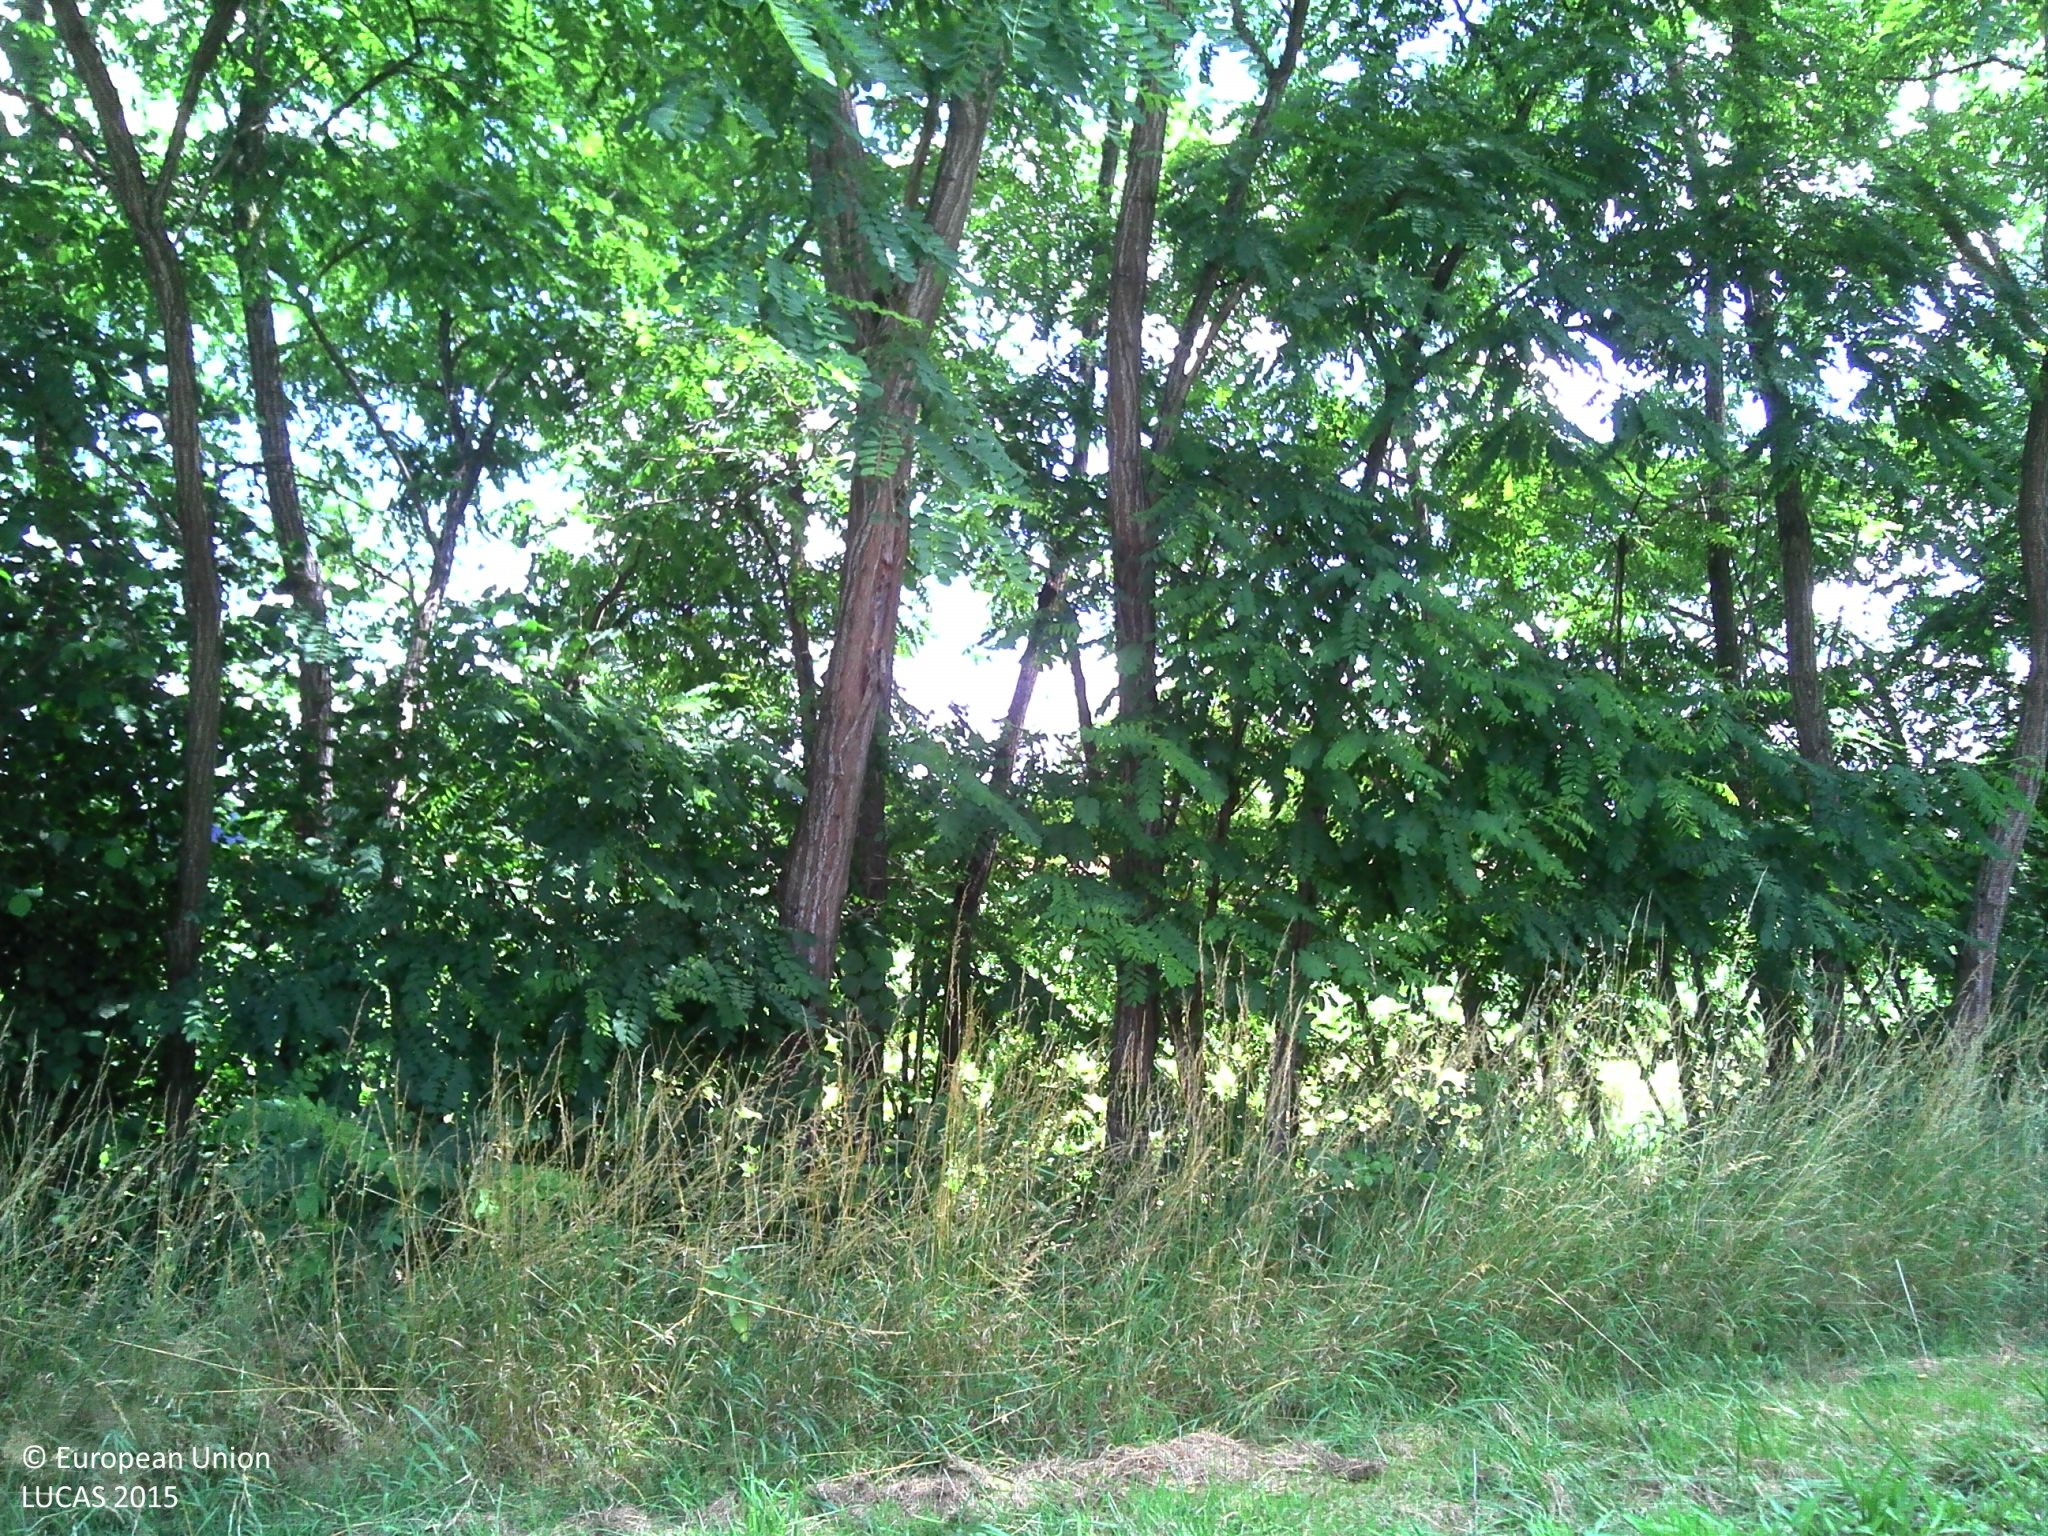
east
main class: Woodland
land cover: Broadleaved woodland
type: acidophilous oak and oak-birch forest
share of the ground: > 75 %
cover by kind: broadleaved forest trees 90 %, shrubs 5 %, herbaceous plants 5 %
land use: Semi-natural and natural areas not in use
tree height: > 5 m
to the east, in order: Broadleaved woodland; Inland marshes; Inland fresh running water; Grass margins; Paved roads, cycling and walking lanes; Grass margins; Broadleaved woodland; Rivers and streams; Grass margins; Maize; Common wheat; Electric lines; Common wheat
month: June
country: FR
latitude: 46.6673
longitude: 3.6335
